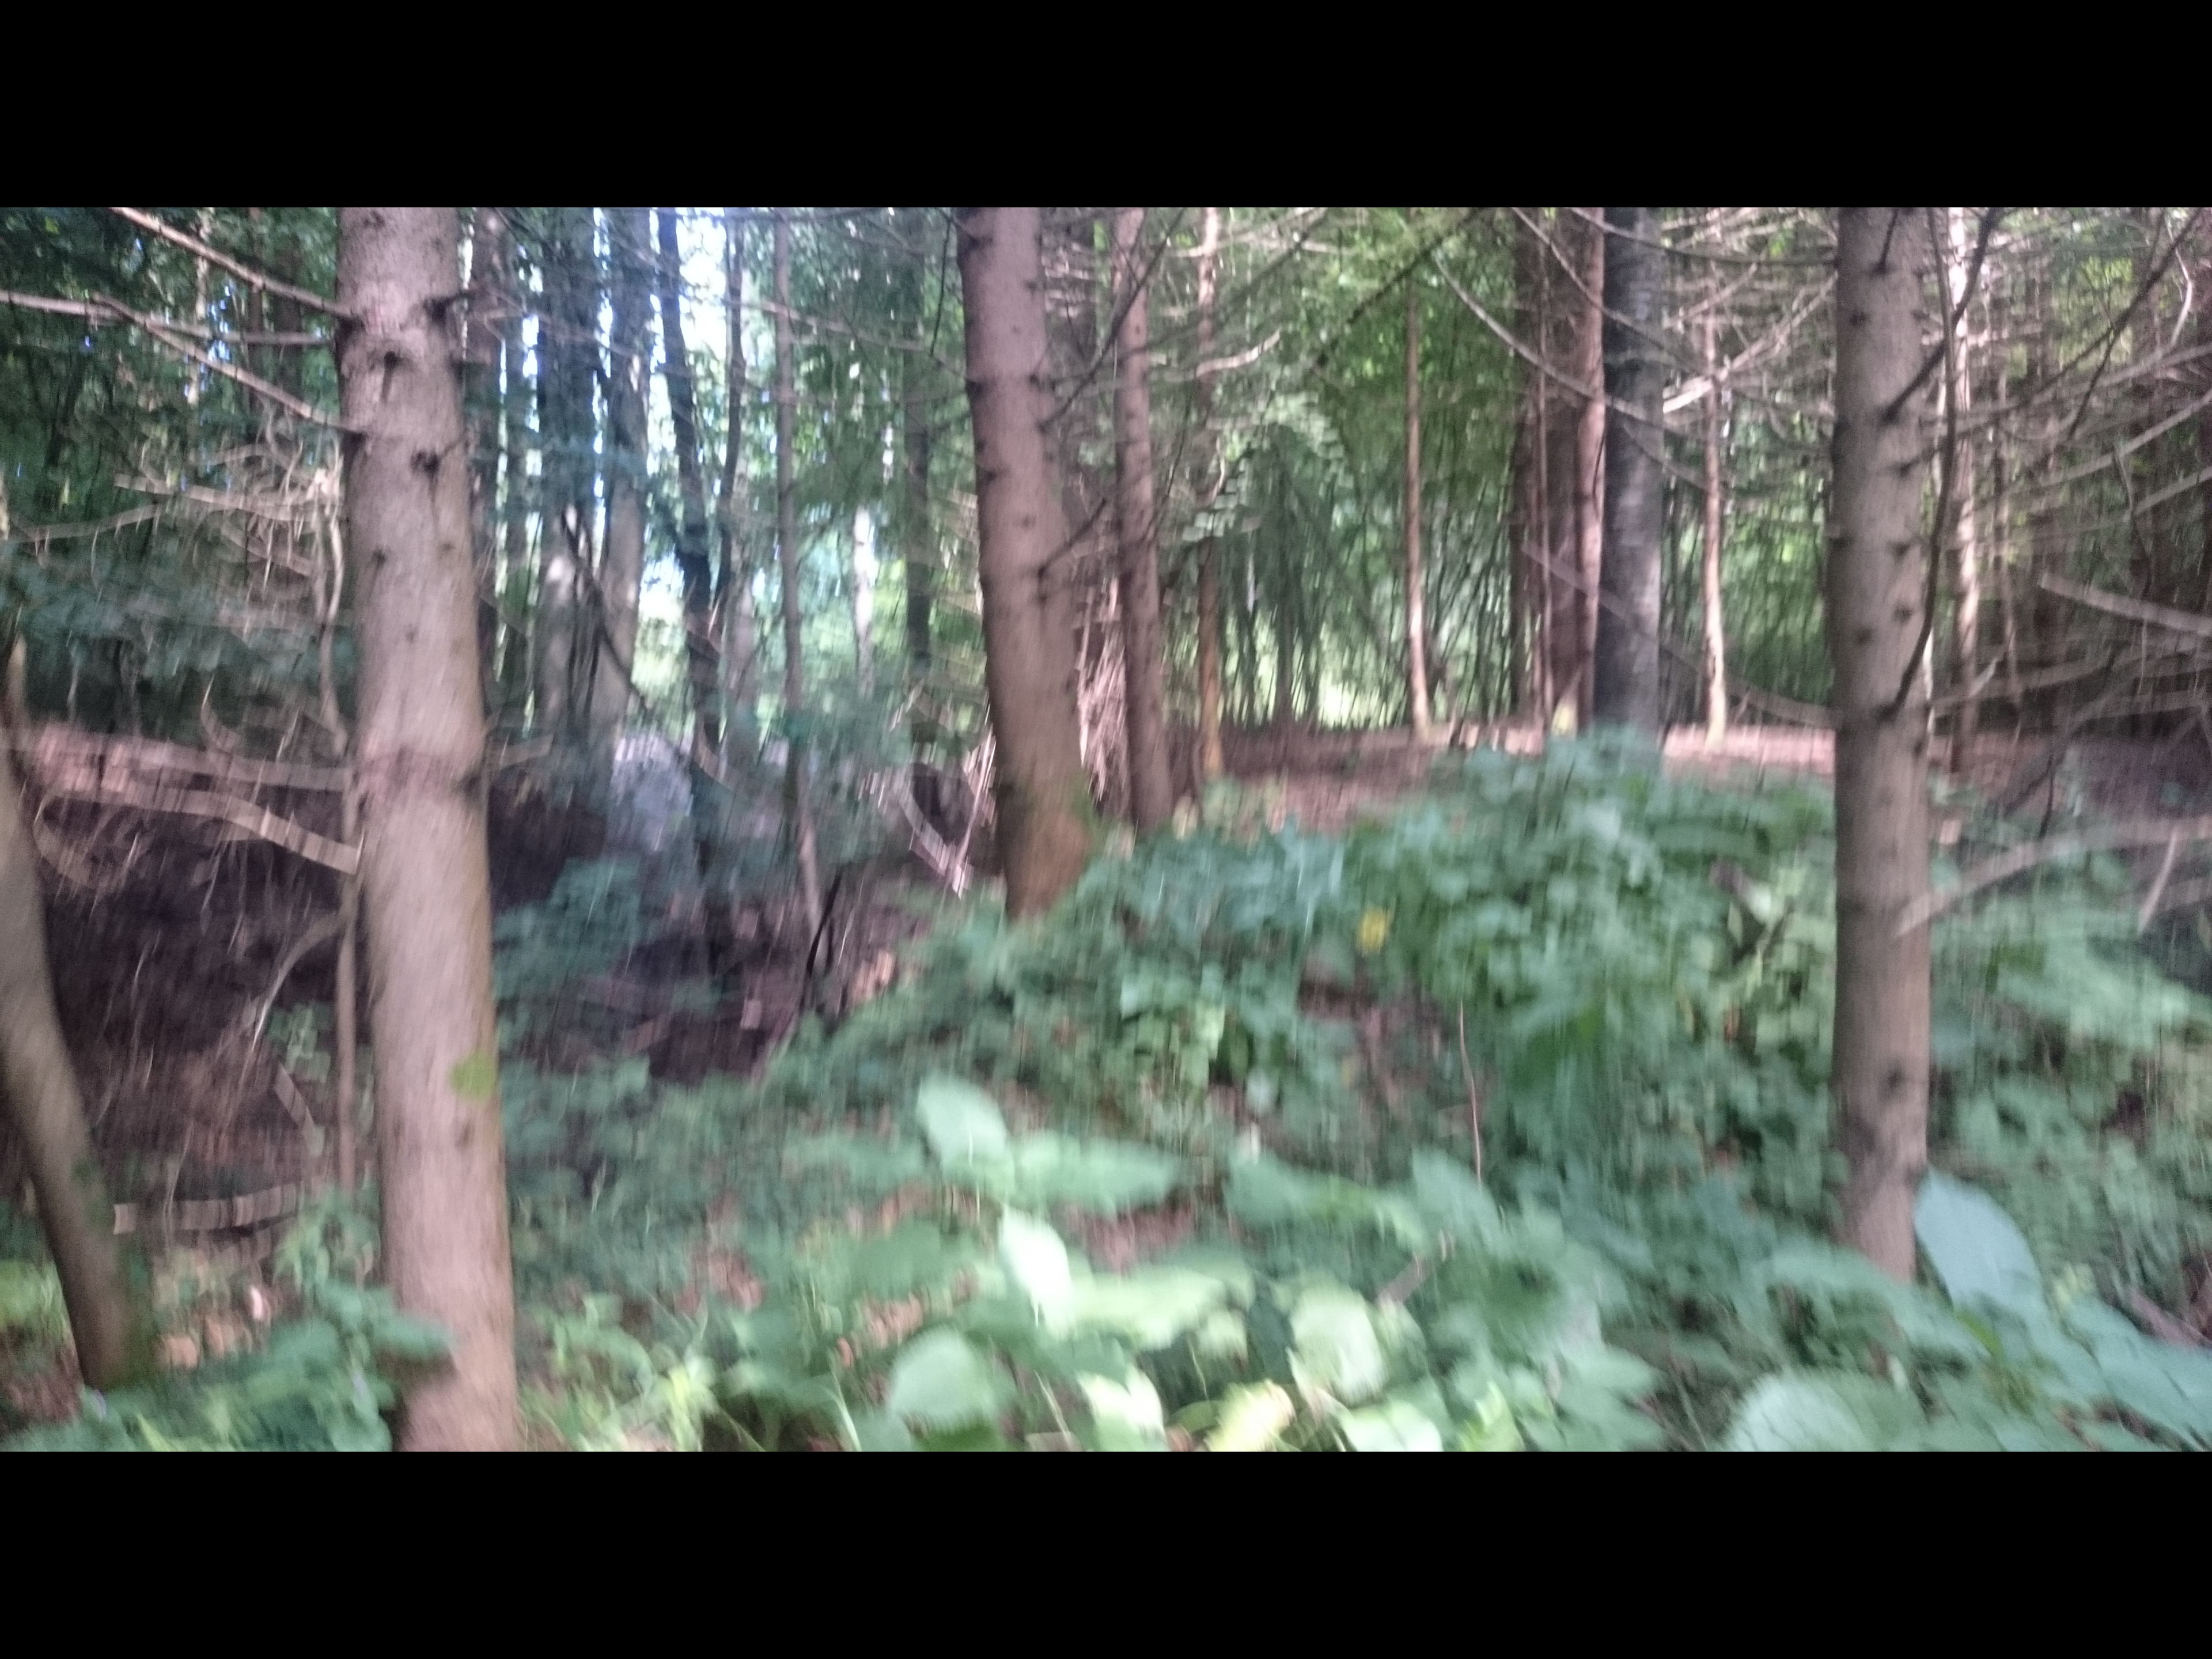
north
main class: Woodland
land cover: Spruce dominated mixed woodland
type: hemiboreal forest and nemoral coniferous forest and mixed broadleaved-coniferous forest
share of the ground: > 75 %
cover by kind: broadleaved forest trees 60 %, coniferous forest trees 30 %, herbaceous plants 10 %
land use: Forestry
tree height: > 5 m
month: July
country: AT
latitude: 47.1429
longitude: 15.6045
